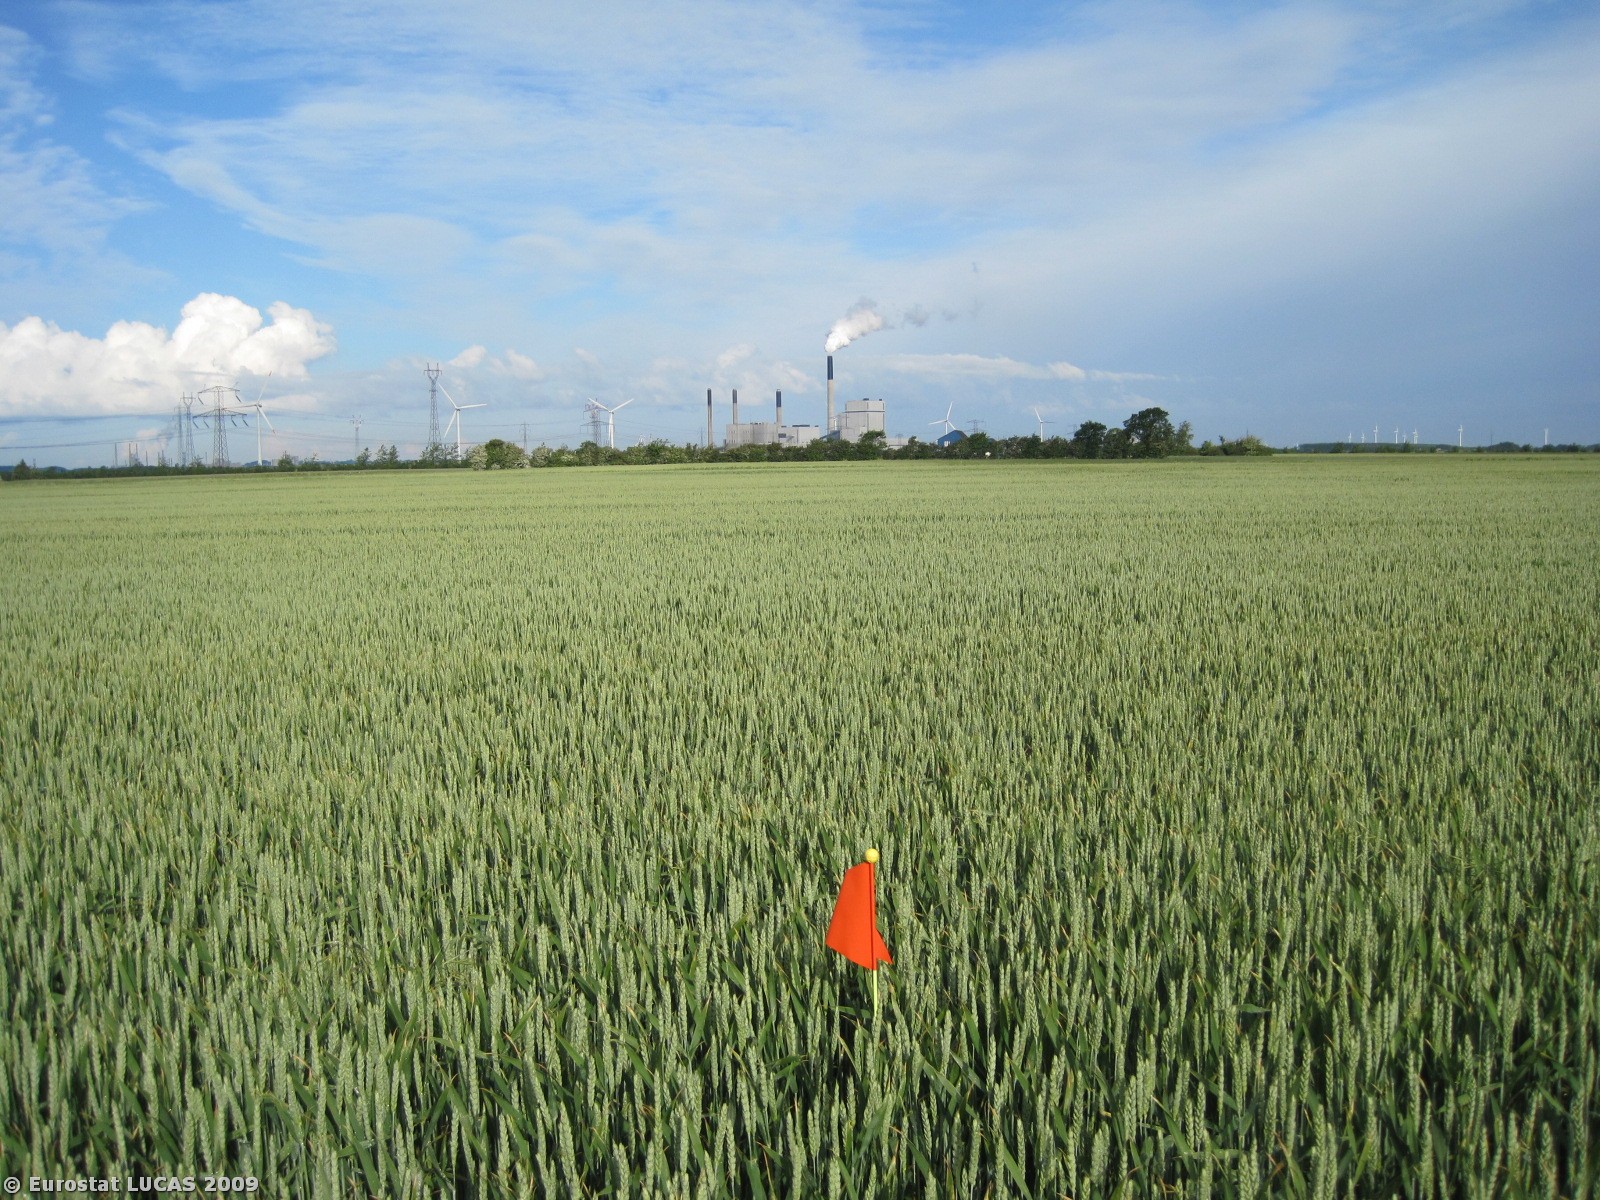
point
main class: Cropland
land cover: Common wheat
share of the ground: > 75 %
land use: Agriculture (excluding fallow land and kitchen gardens)
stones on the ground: < 10 %
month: June
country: DK
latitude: 57.0686
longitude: 10.0823
